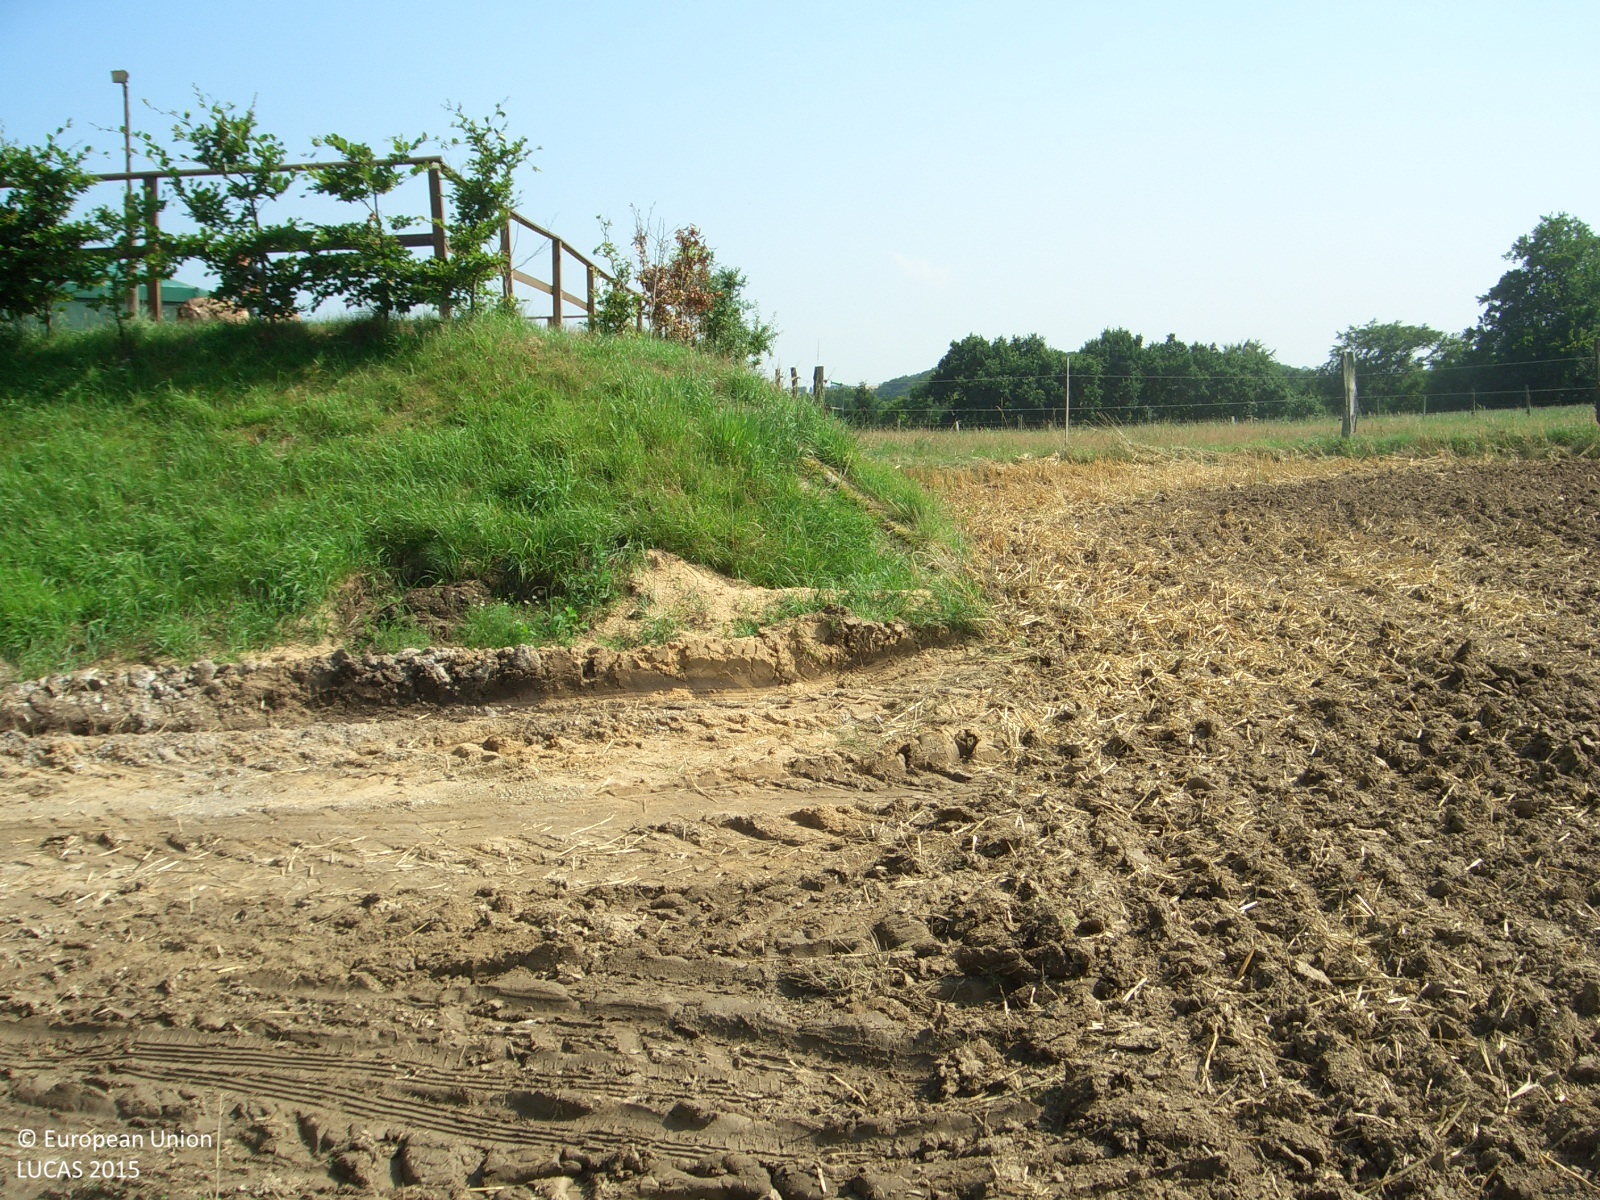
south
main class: Cropland
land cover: Barley
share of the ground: < 10 %
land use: Agriculture (excluding fallow land and kitchen gardens)
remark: Harvested field
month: July
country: DE
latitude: 51.3674
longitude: 6.9692
